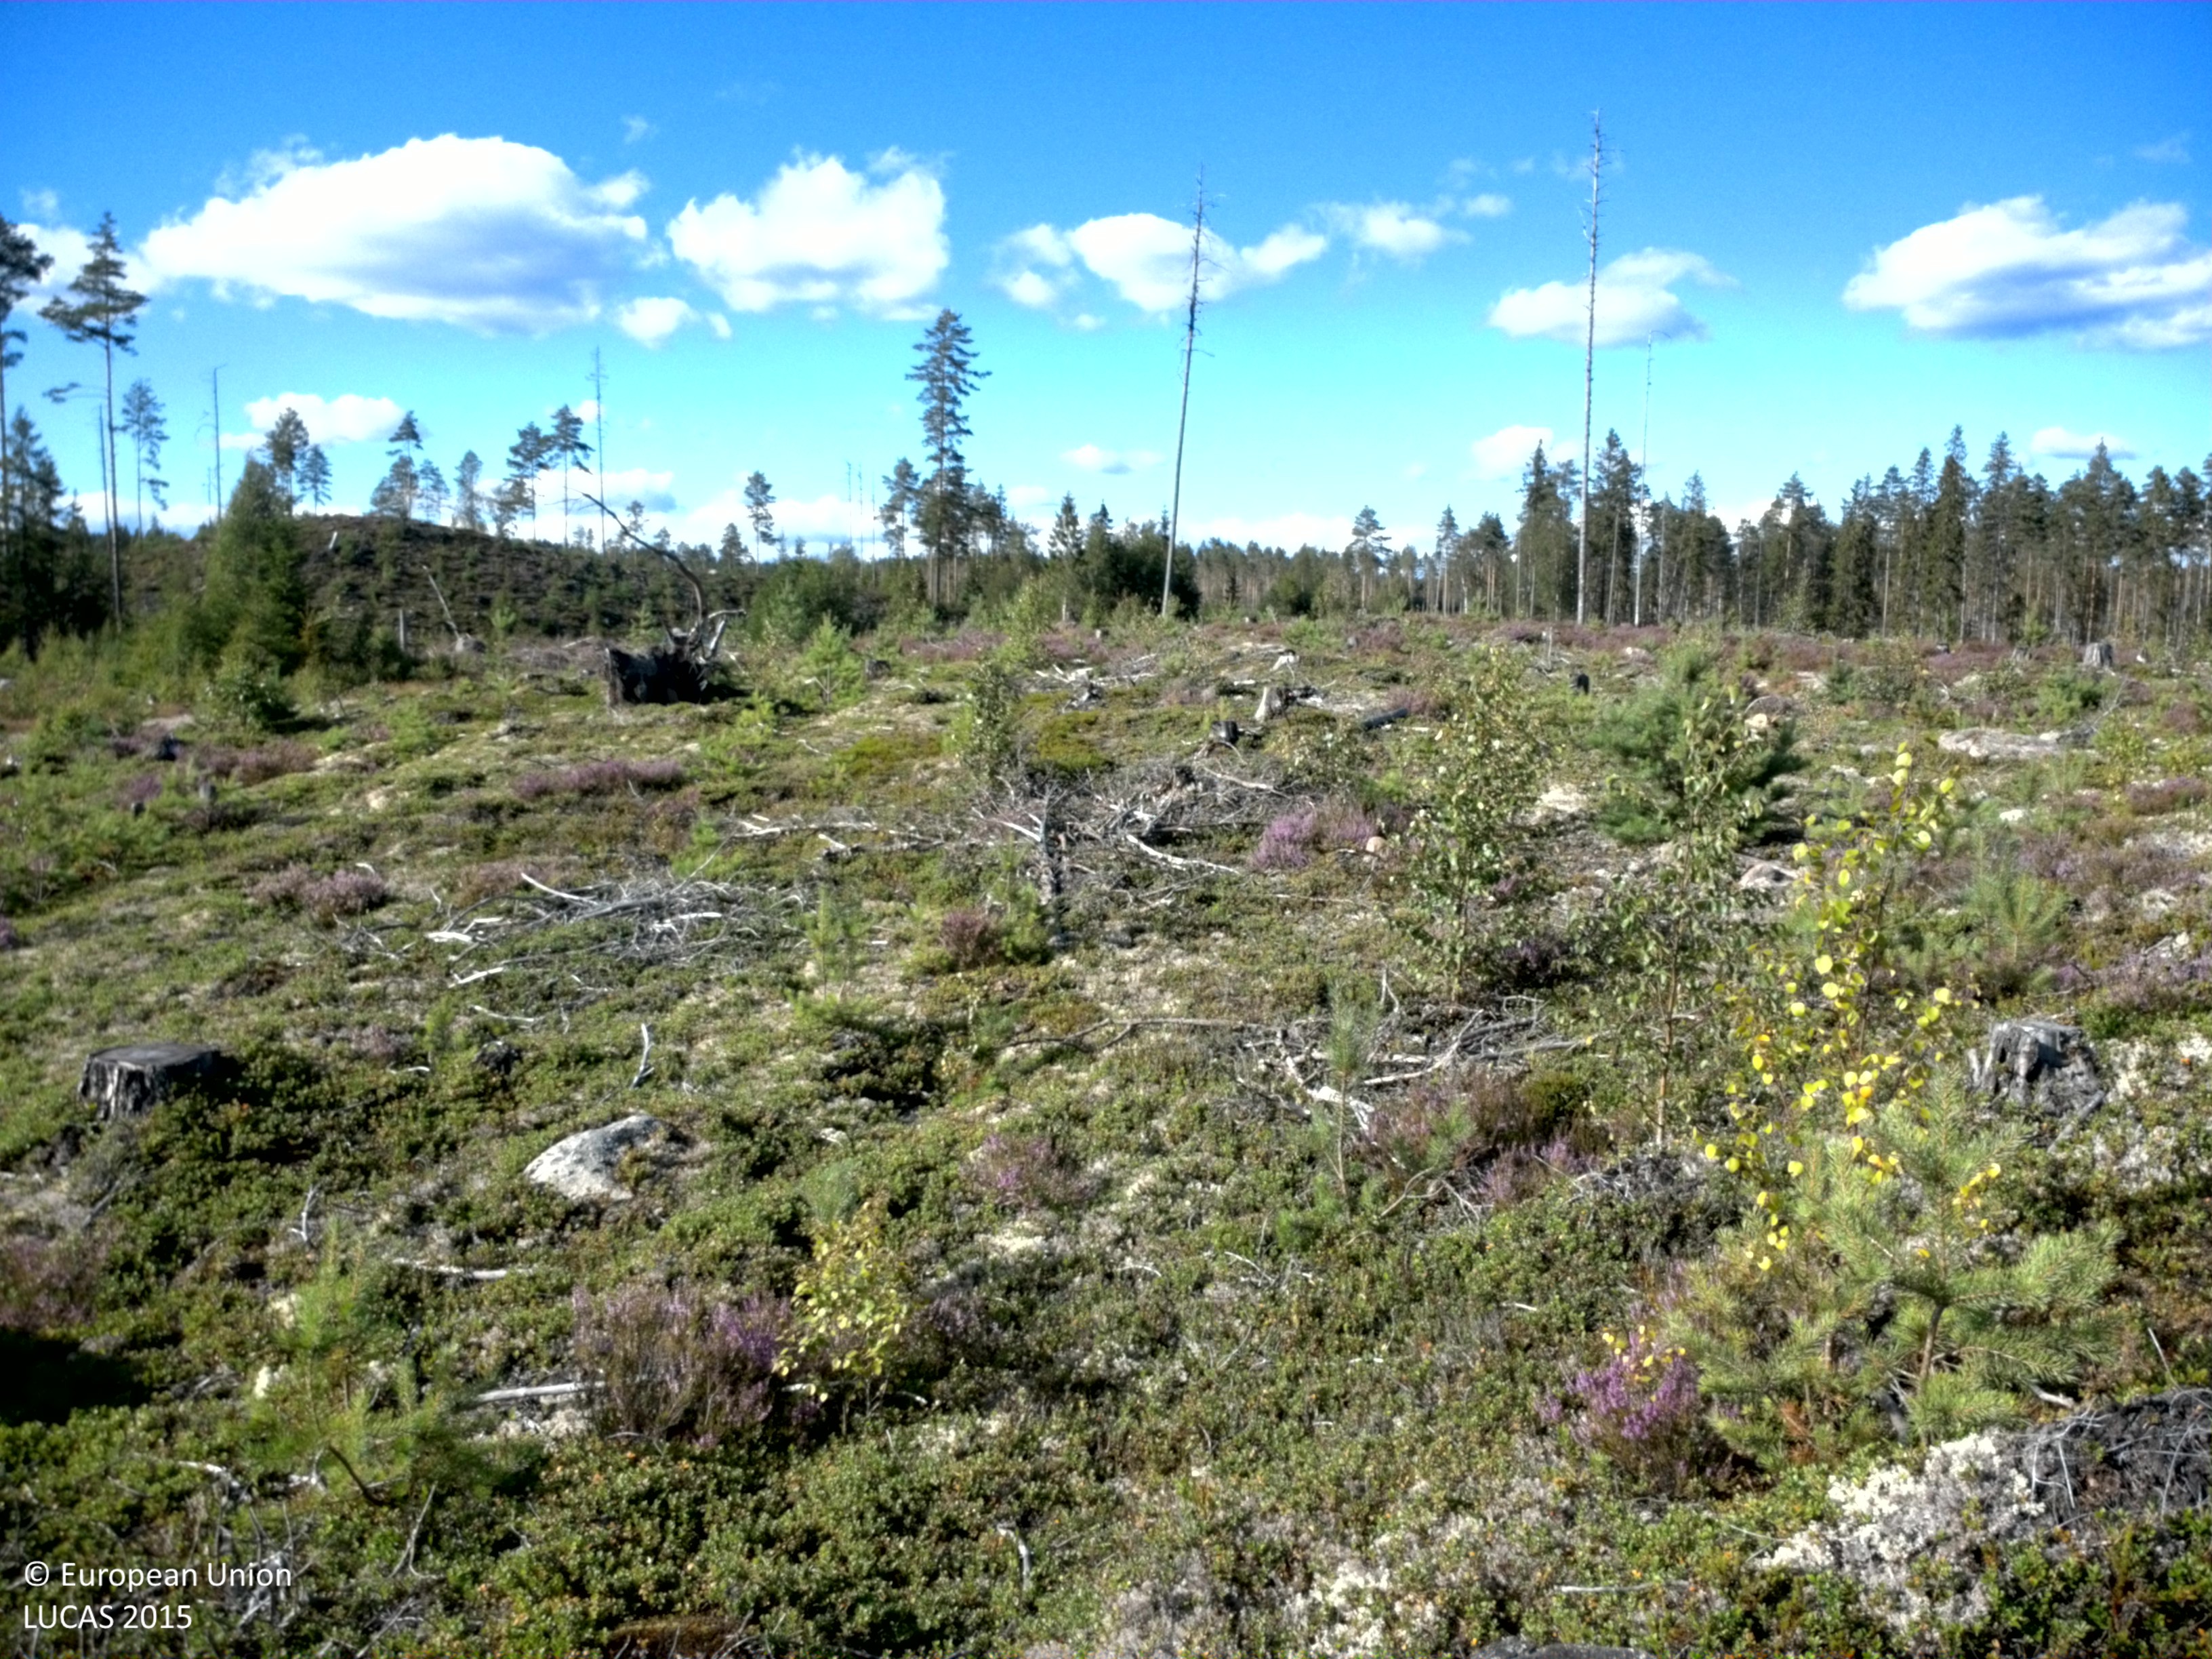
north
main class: Woodland
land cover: Pine dominated mixed woodland
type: boreal forest
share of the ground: 25 - 50 %
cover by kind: shrubs 45 %, lichens and mosses 20 %, coniferous forest trees 15 %, broadleaved forest trees 15 %, herbaceous plants 5 %
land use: Forestry
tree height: < 5 m
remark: Clear cut
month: August
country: SE
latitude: 60.2441
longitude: 13.5487
